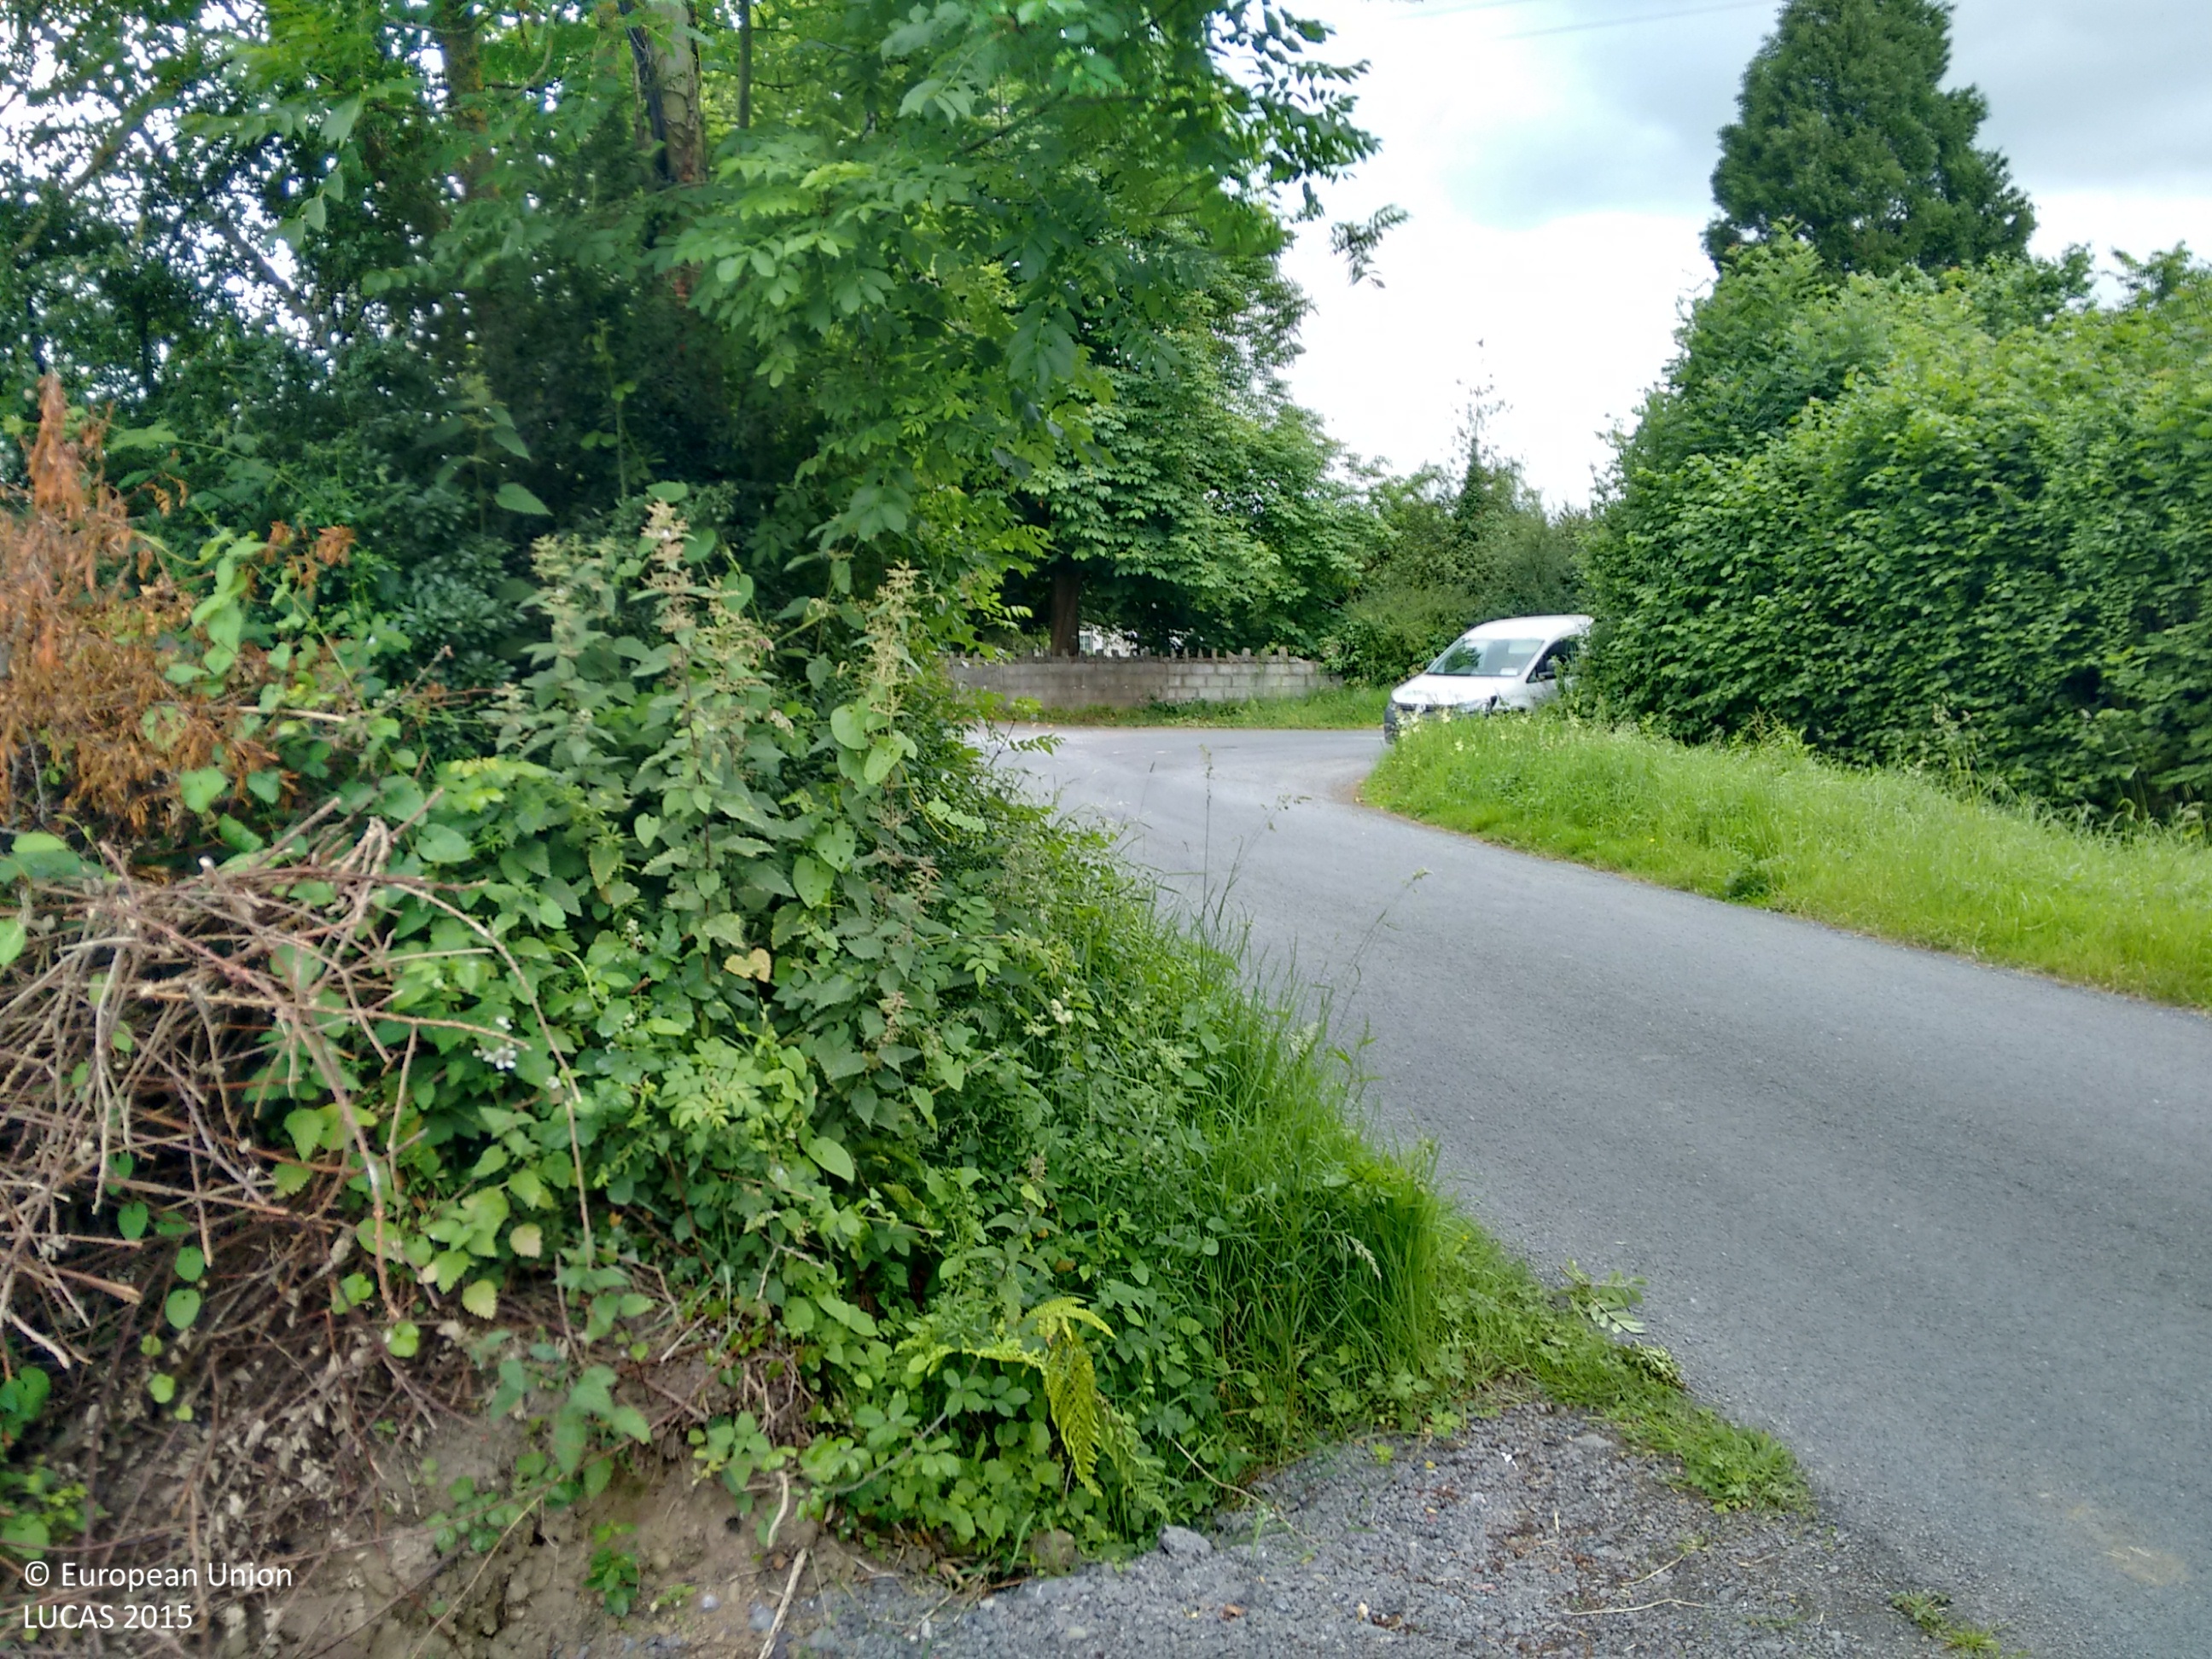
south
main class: Grassland
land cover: Grassland without tree/shrub cover
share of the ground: > 75 %
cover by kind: herbaceous plants 100 %
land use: Agriculture (excluding fallow land and kitchen gardens)
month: July
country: IE
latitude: 52.5650
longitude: -7.4320
